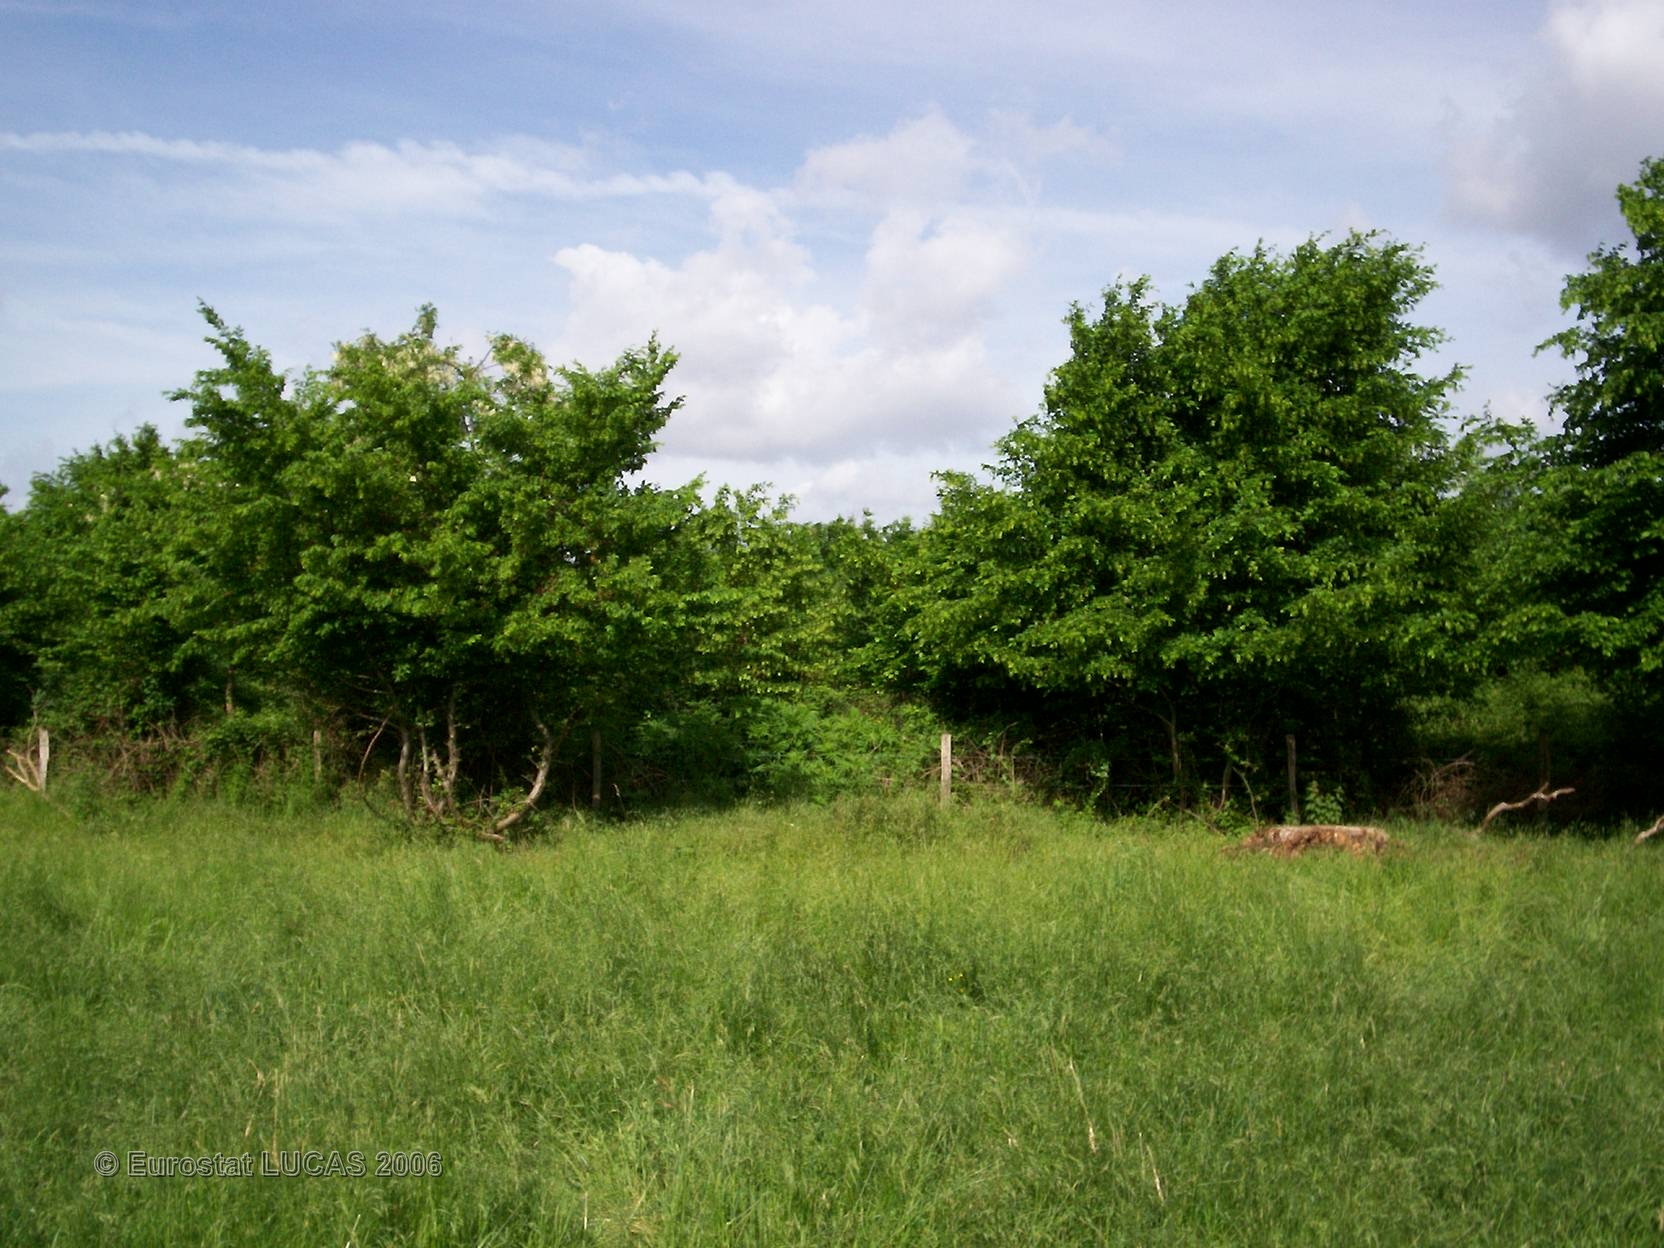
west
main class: Grassland
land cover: Grassland without tree/shrub cover
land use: Agriculture (excluding fallow land and kitchen gardens)
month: May
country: FR
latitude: 45.8878
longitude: 0.4619
